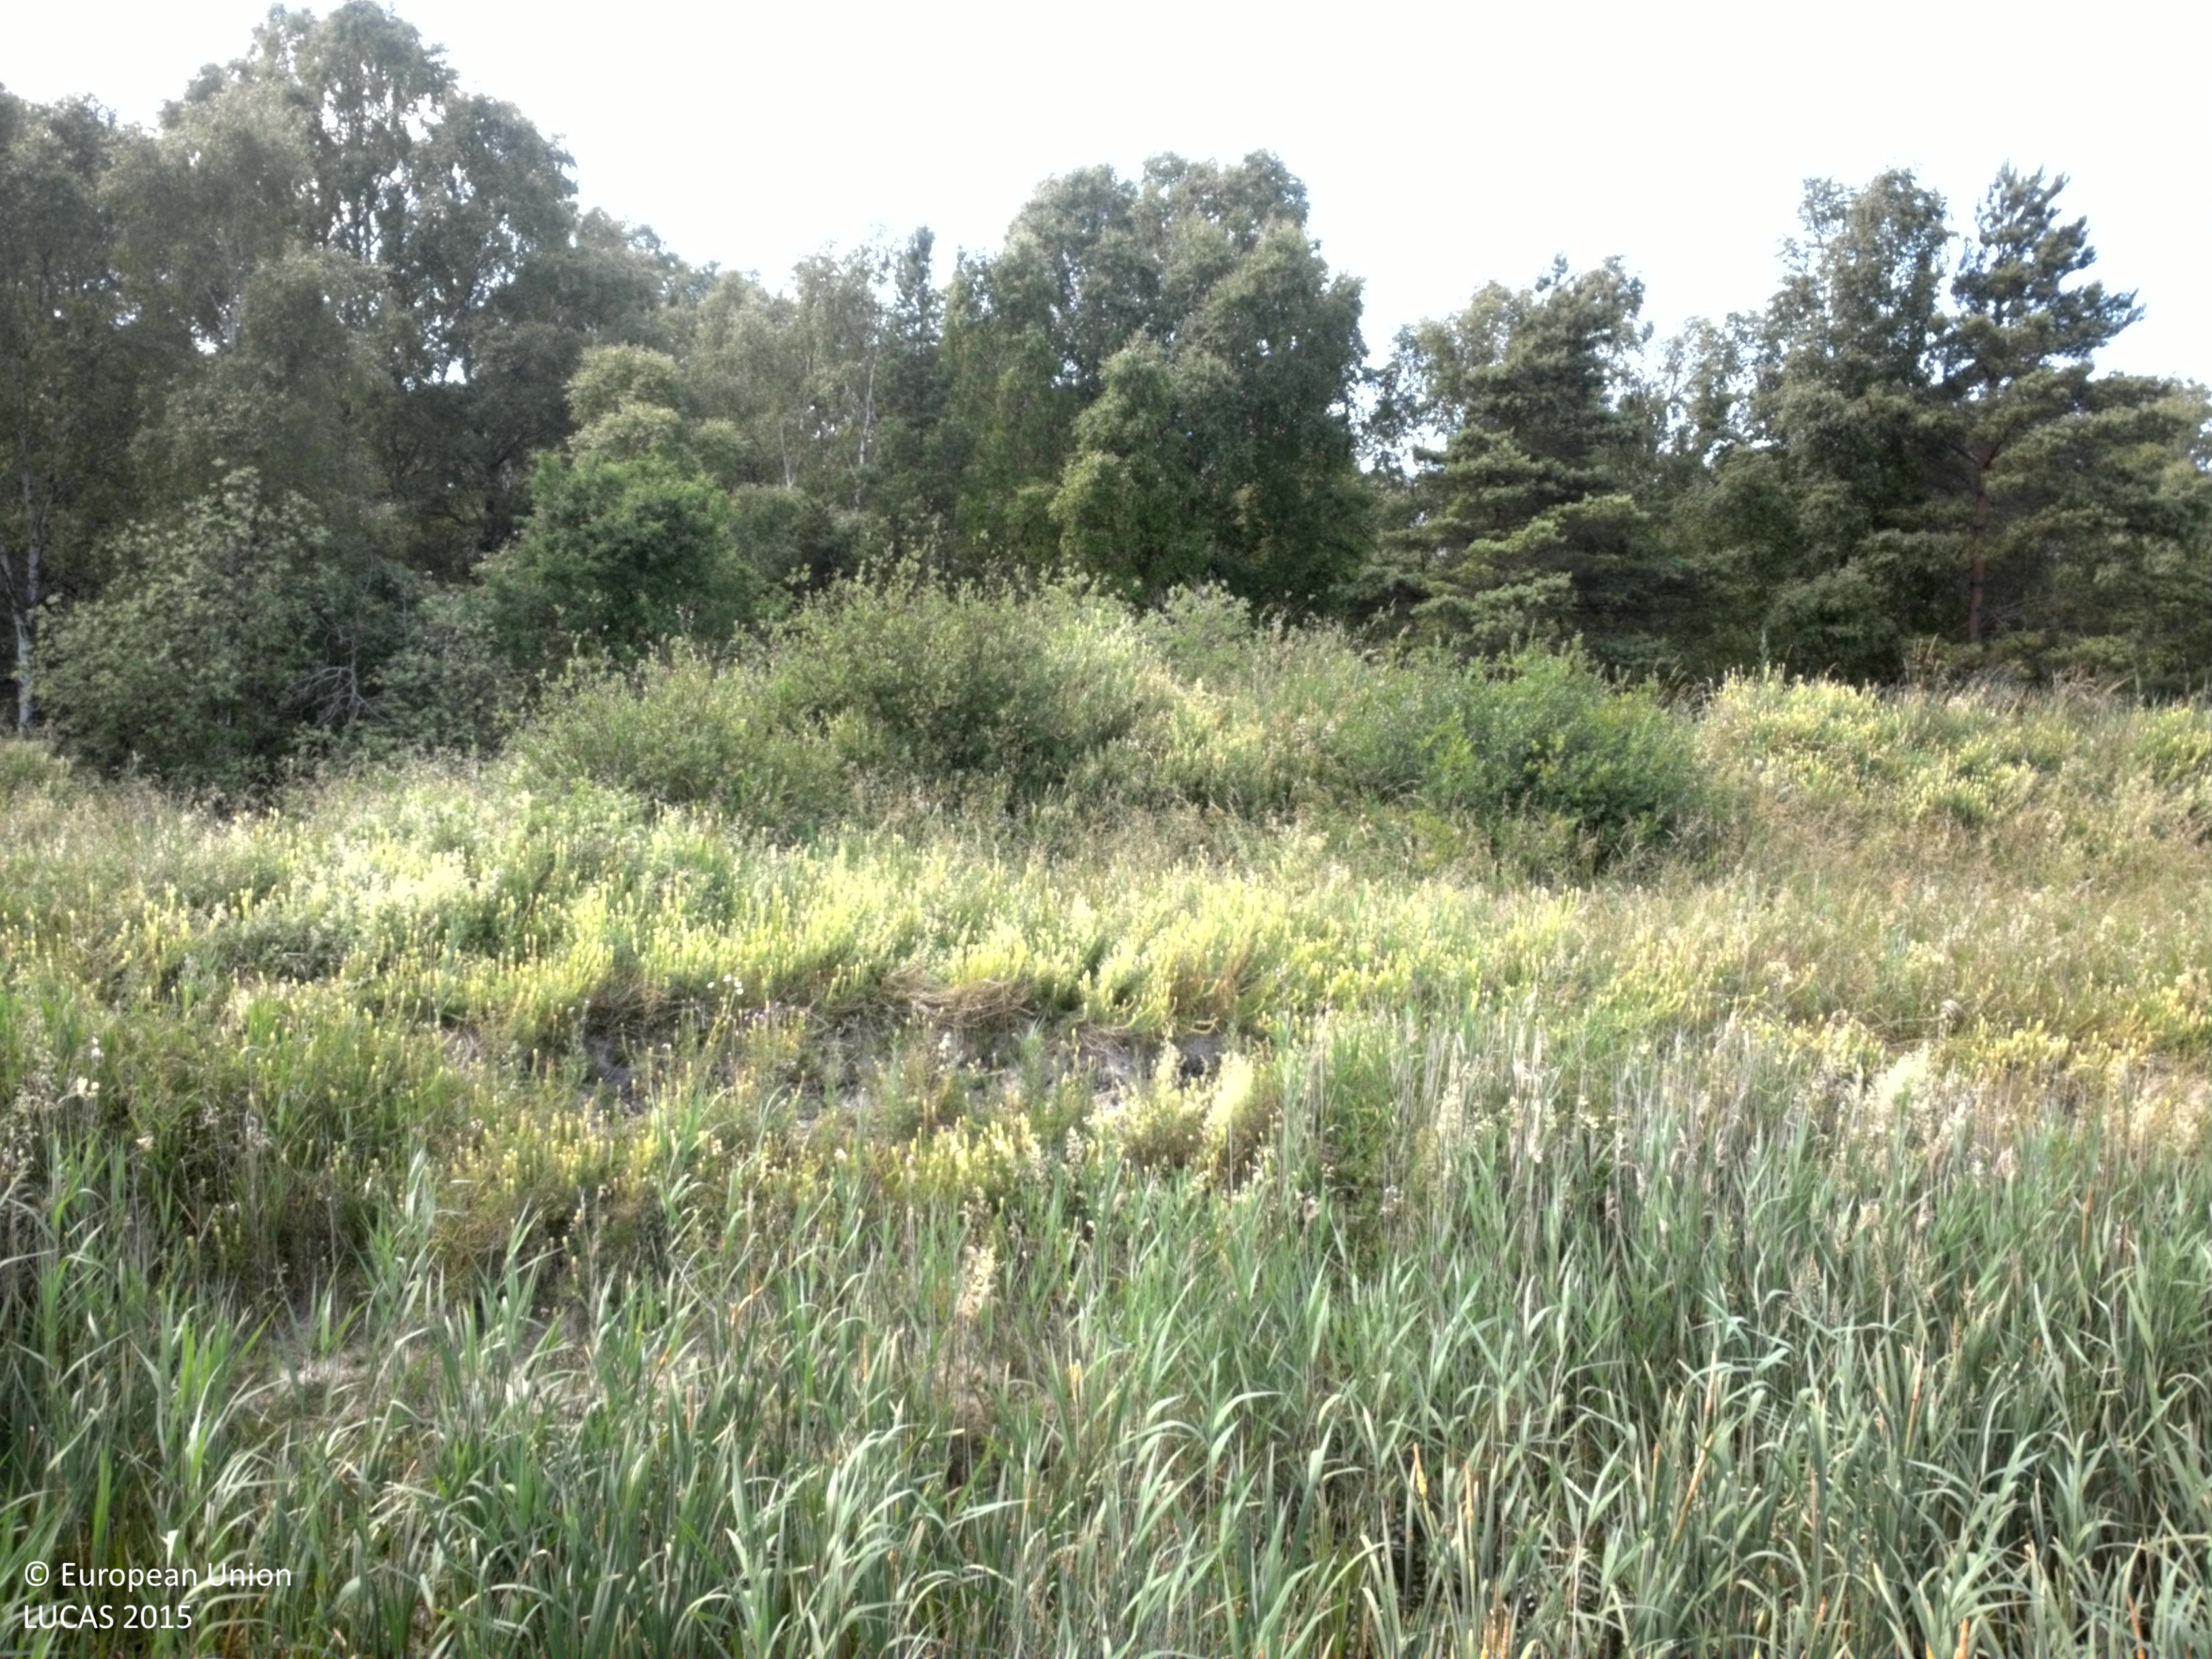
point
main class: Grassland
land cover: Spontaneously vegetated surfaces
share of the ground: > 75 %
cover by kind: herbaceous plants 95 %, shrubs 5 %
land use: Agriculture (excluding fallow land and kitchen gardens)
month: July
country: SE
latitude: 57.7293
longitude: 18.5556
